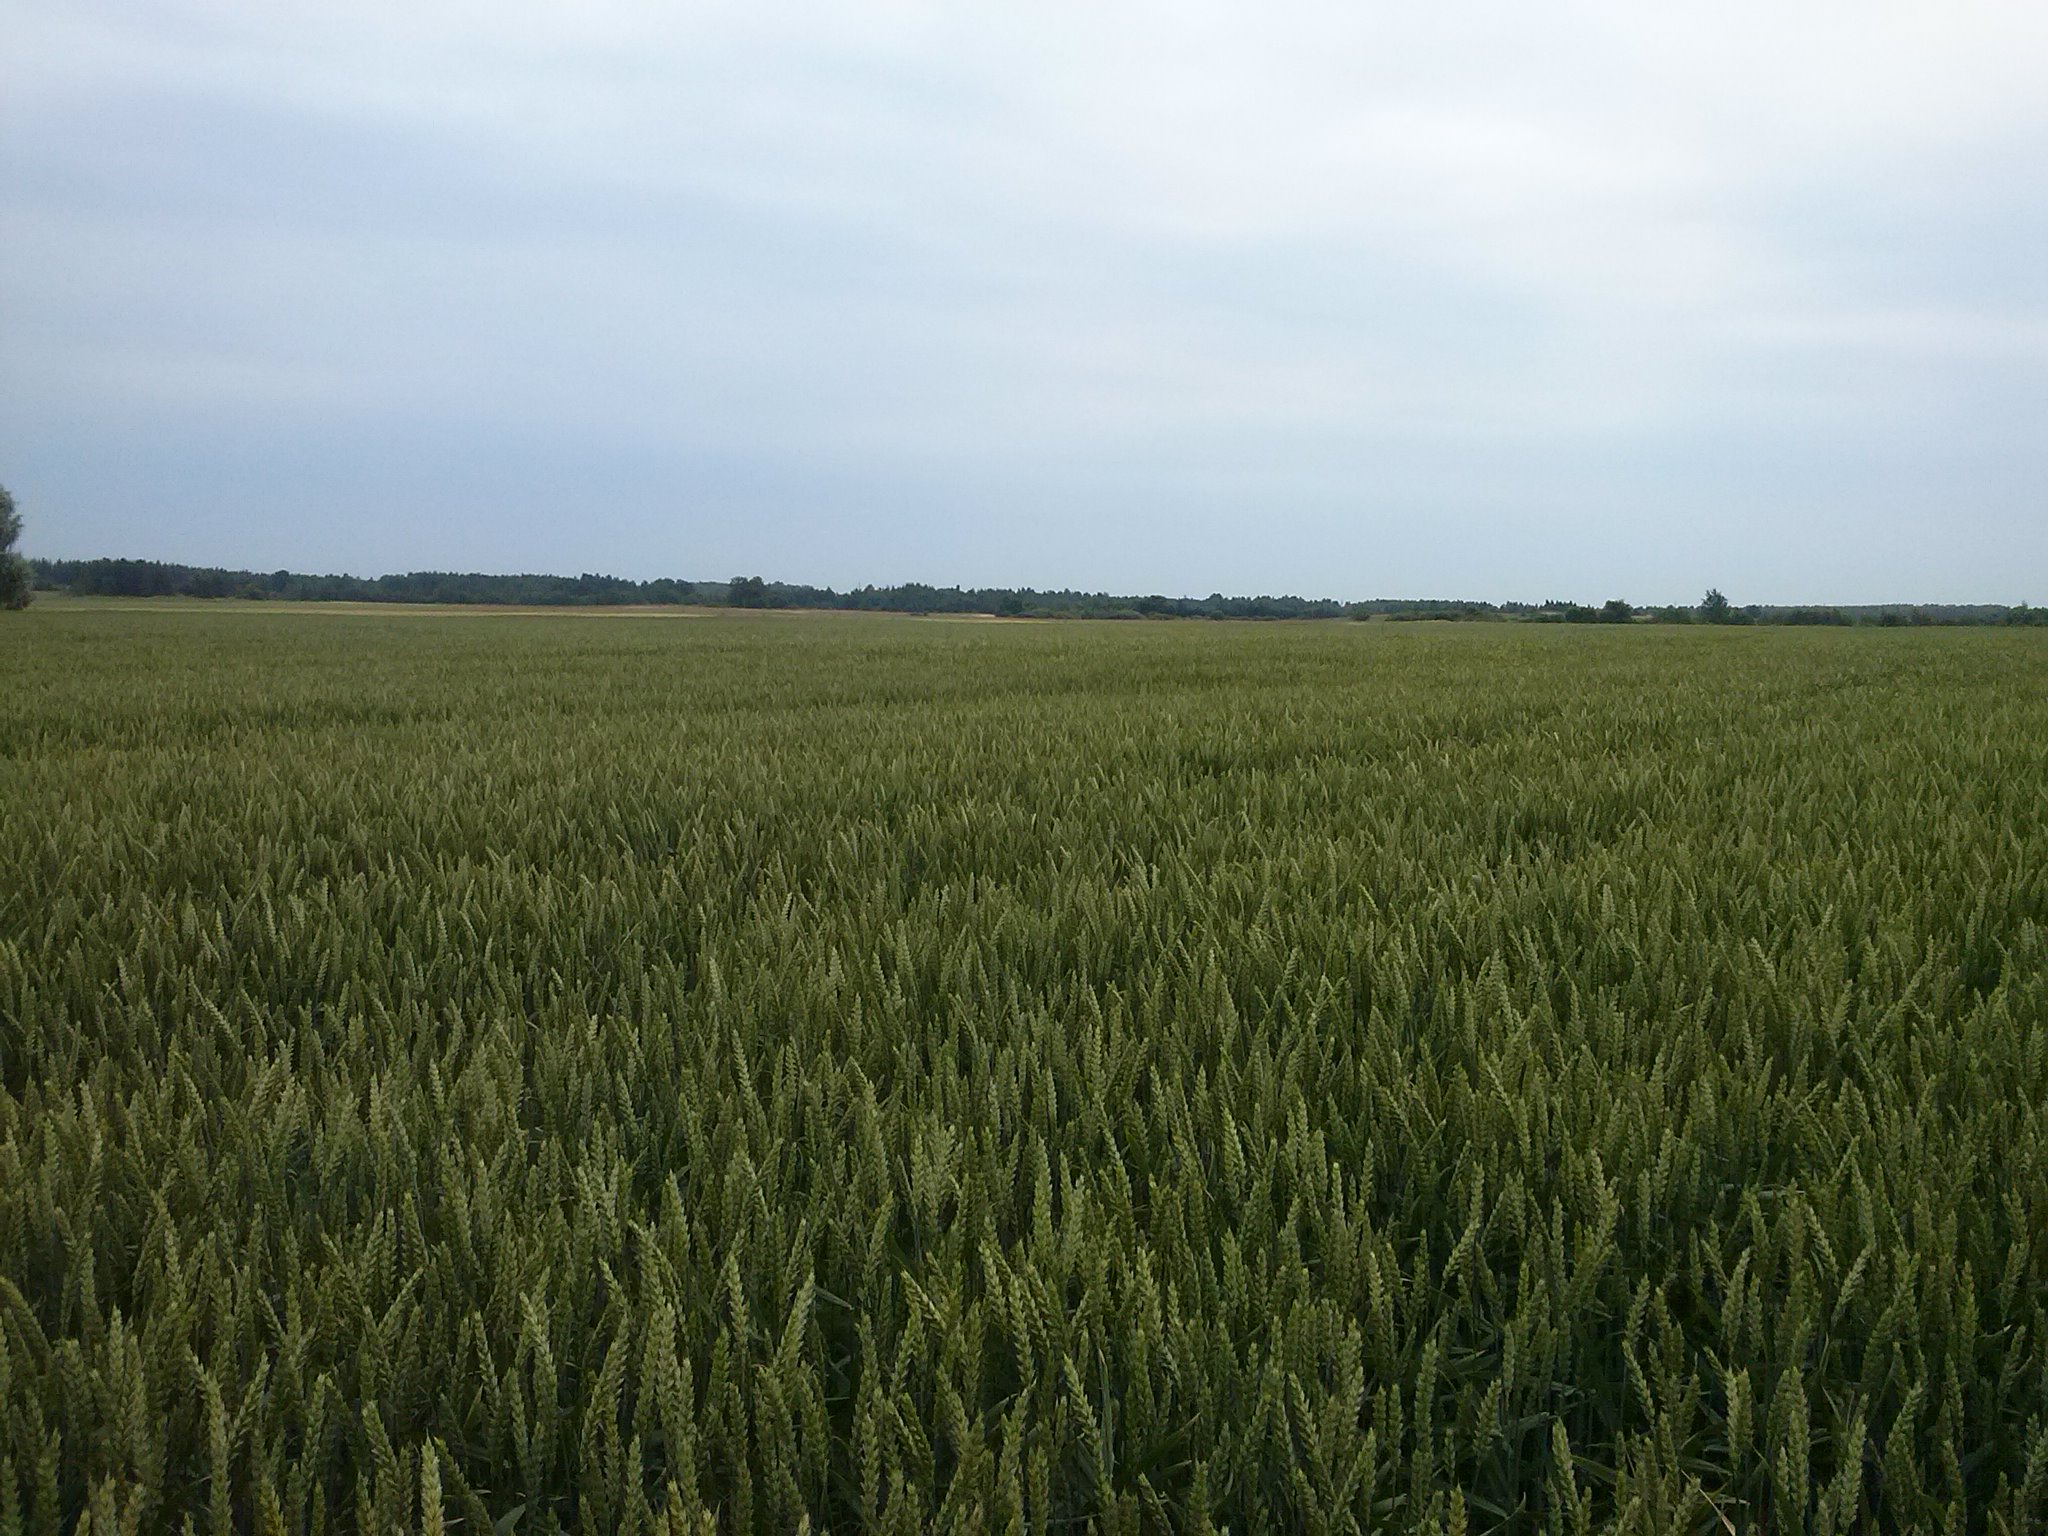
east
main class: Cropland
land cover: Common wheat
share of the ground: > 75 %
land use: Agriculture (excluding fallow land and kitchen gardens)
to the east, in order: Common wheat
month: July
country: LV
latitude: 56.7871
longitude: 27.4456
